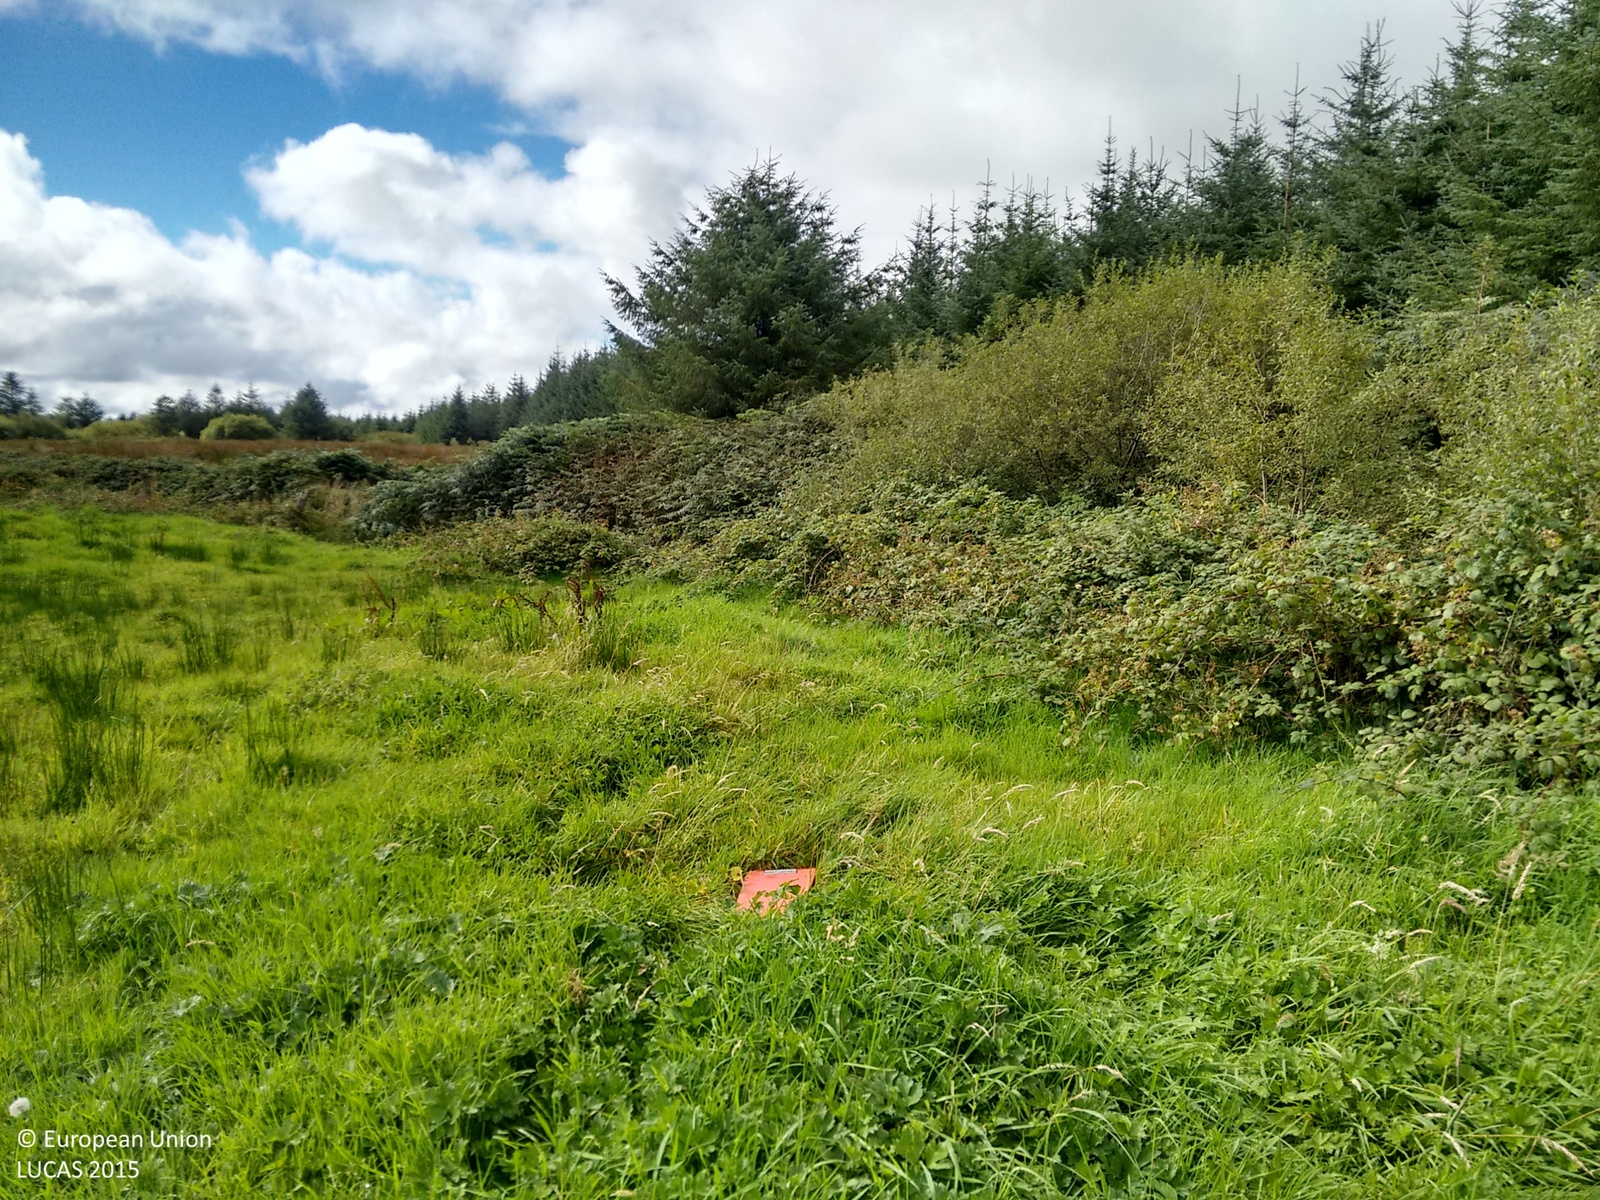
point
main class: Grassland
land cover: Grassland without tree/shrub cover
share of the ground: > 75 %
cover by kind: herbaceous plants 95 %
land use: Agriculture (excluding fallow land and kitchen gardens)
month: September
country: IE
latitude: 52.9201
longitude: -9.1834
